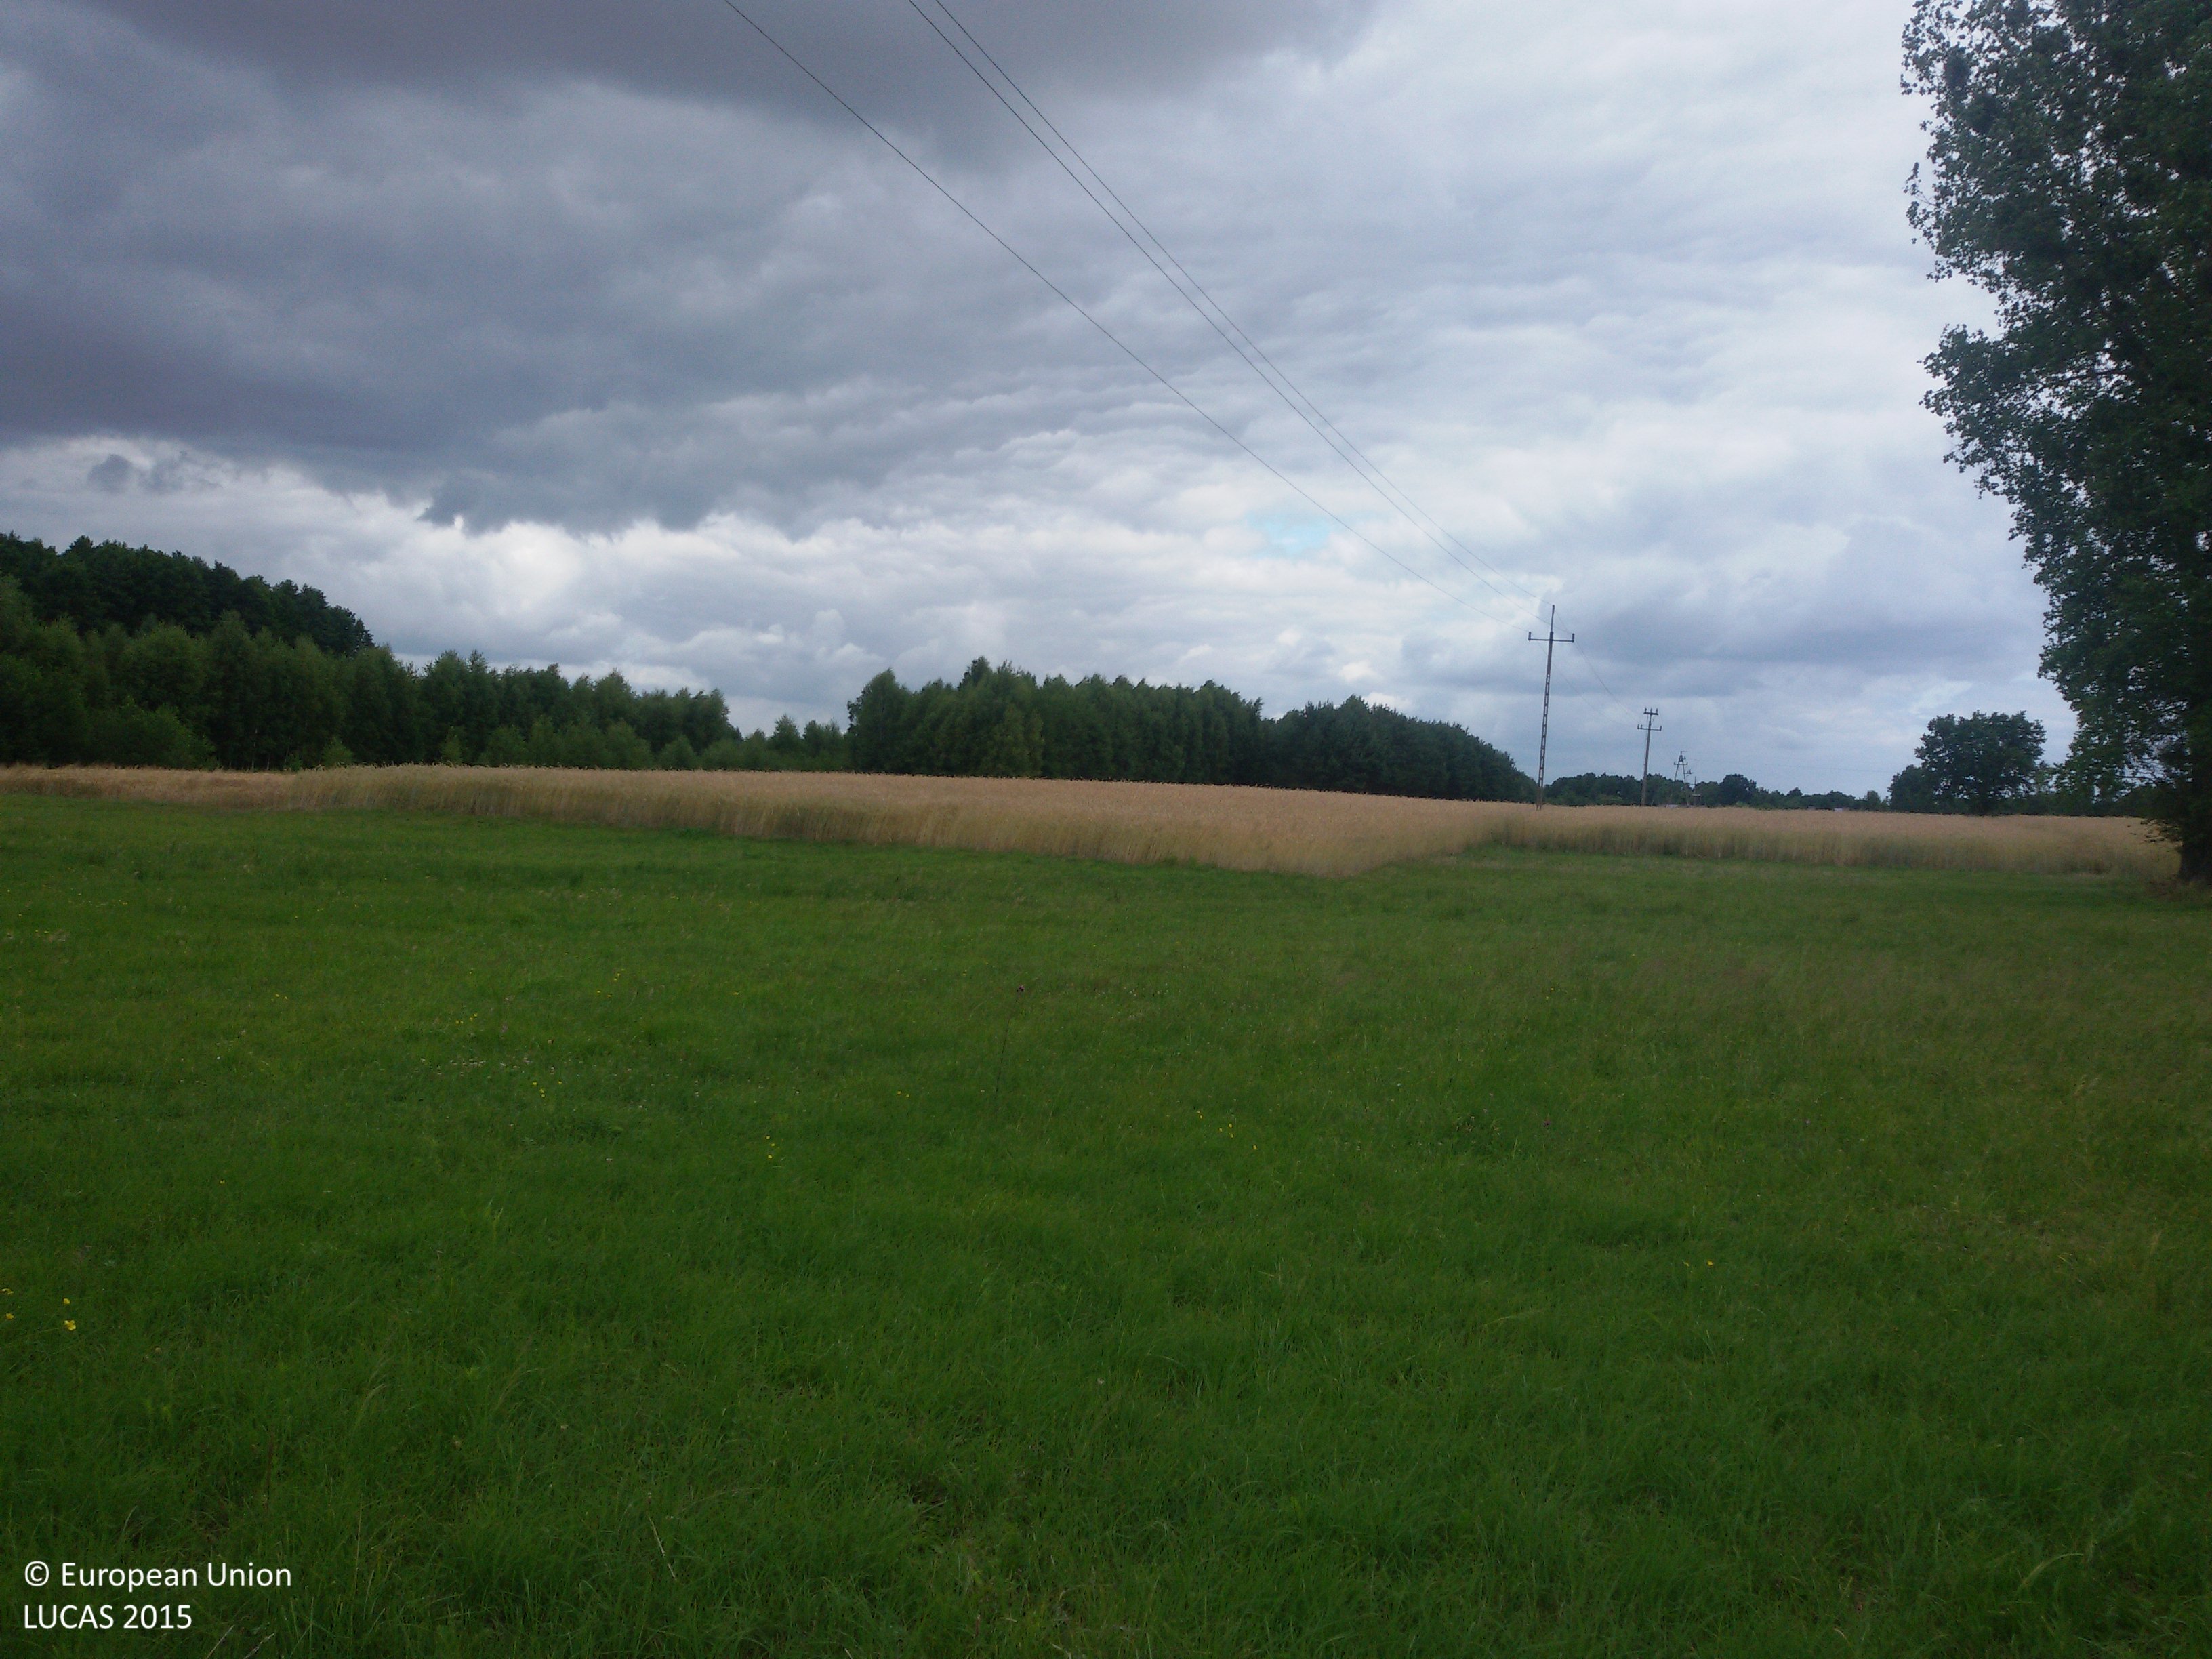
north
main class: Grassland
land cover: Grassland without tree/shrub cover
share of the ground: > 75 %
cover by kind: herbaceous plants 100 %
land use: Agriculture (excluding fallow land and kitchen gardens)
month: July
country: PL
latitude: 51.2439
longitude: 23.5948
